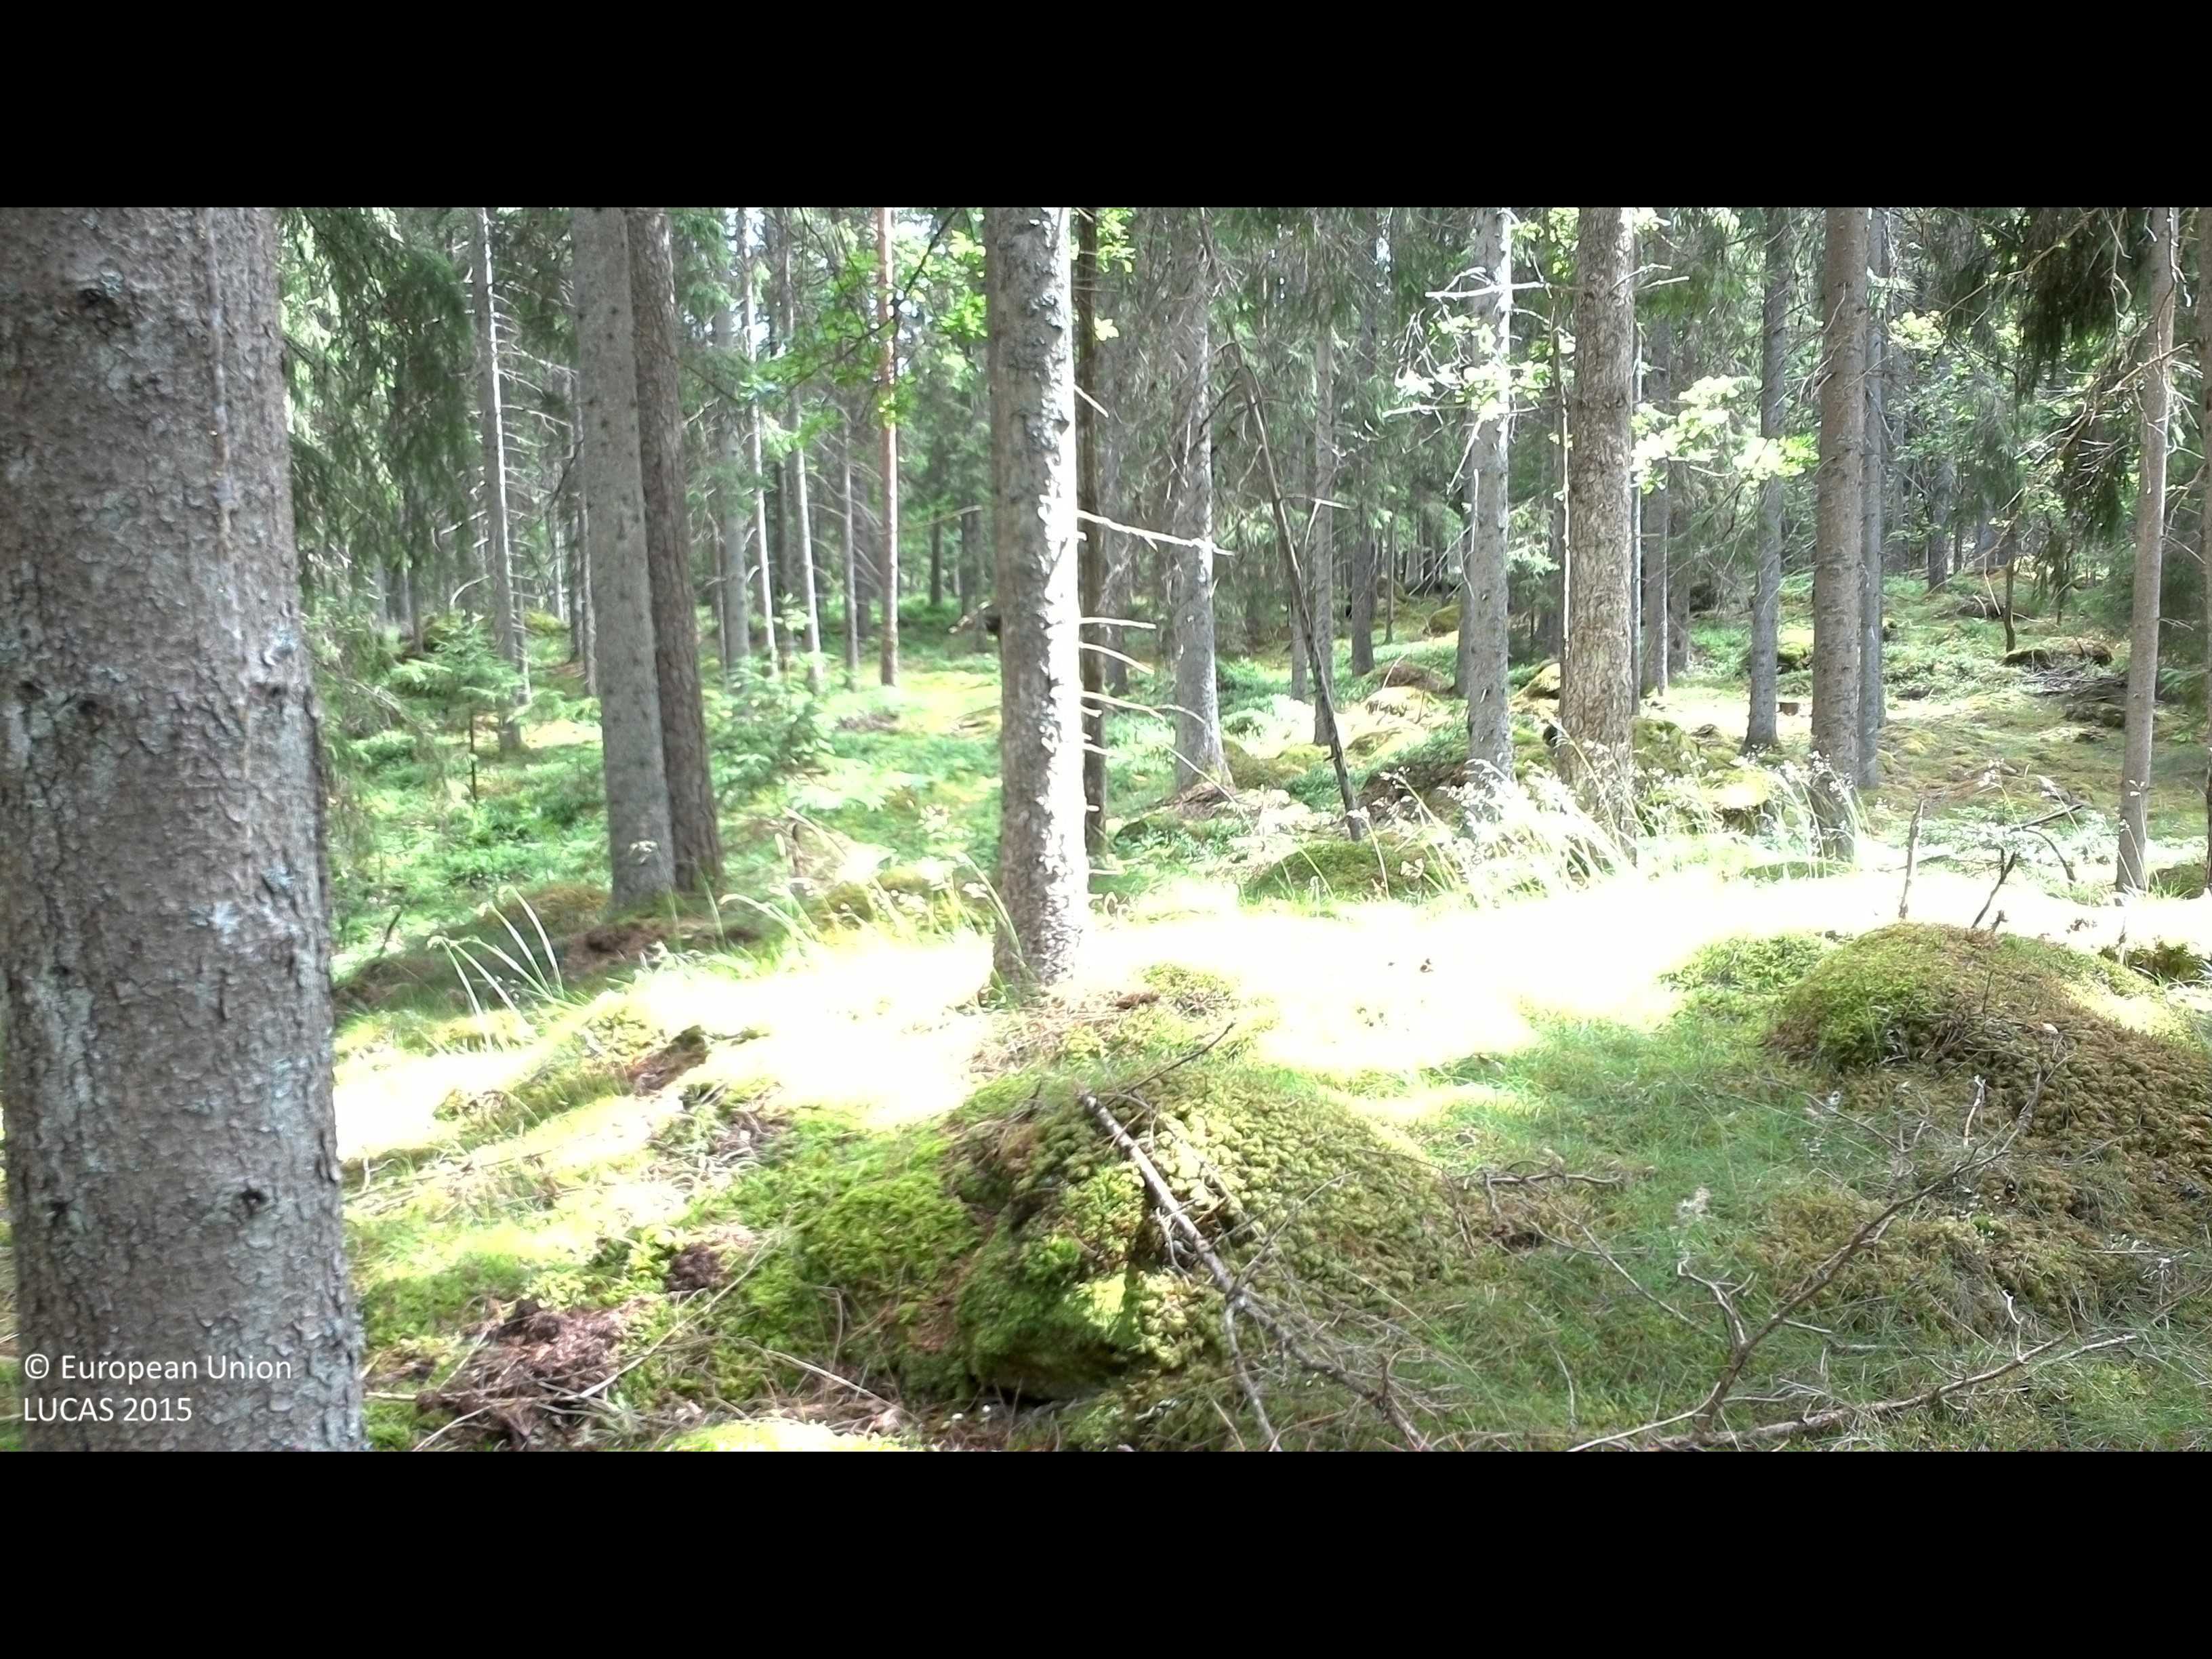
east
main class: Woodland
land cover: Spruce dominated coniferous woodland
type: boreal forest
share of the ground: 50 - 75 %
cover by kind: coniferous forest trees 75 %, lichens and mosses 20 %, herbaceous plants 5 %
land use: Forestry
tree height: > 5 m
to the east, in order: Spruce dominated coniferous woodland; Grassland with sparse tree/shrub cover; Spruce dominated coniferous woodland; Broadleaved woodland
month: July
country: SE
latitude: 56.3901
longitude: 15.1659
